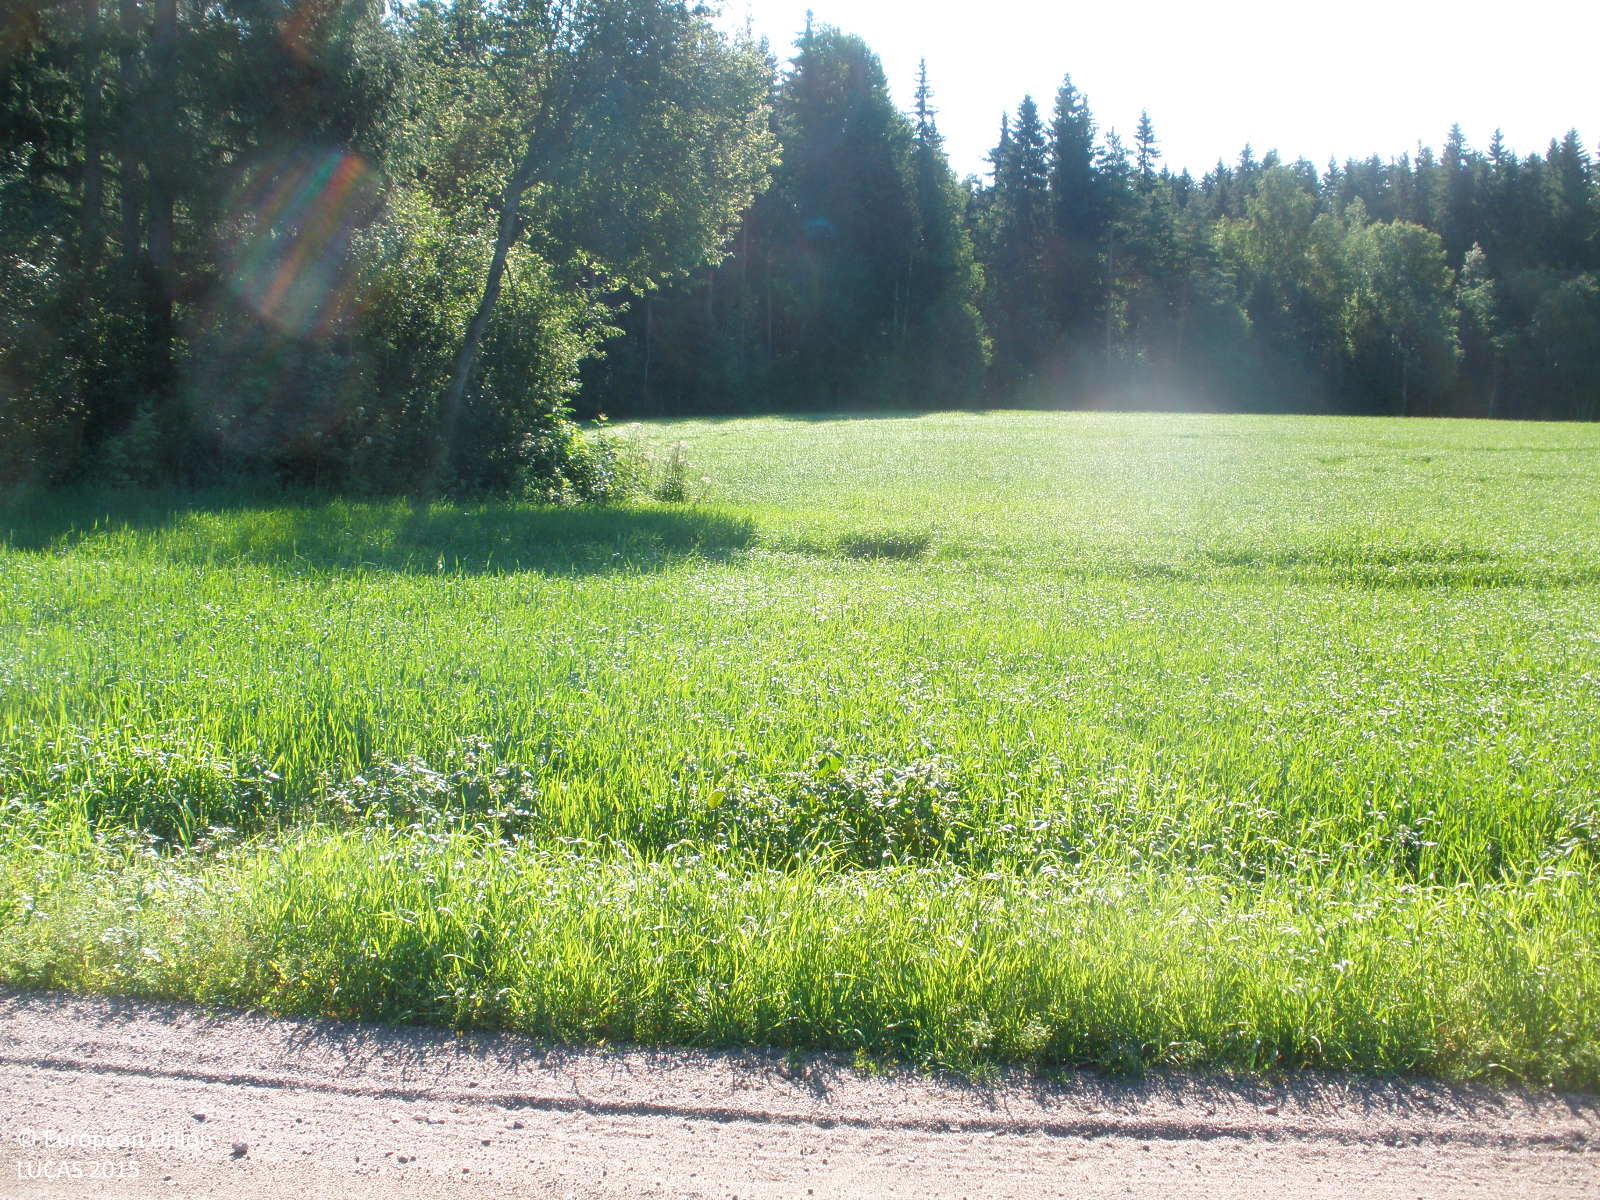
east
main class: Cropland
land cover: Barley
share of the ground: > 75 %
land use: Agriculture (excluding fallow land and kitchen gardens)
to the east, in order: Barley; Grass margins; Tracks; Grass margins; Barley; Spruce dominated mixed woodland; Barley; Spruce dominated mixed woodland
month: July
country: FI
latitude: 61.0100
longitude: 25.1548
